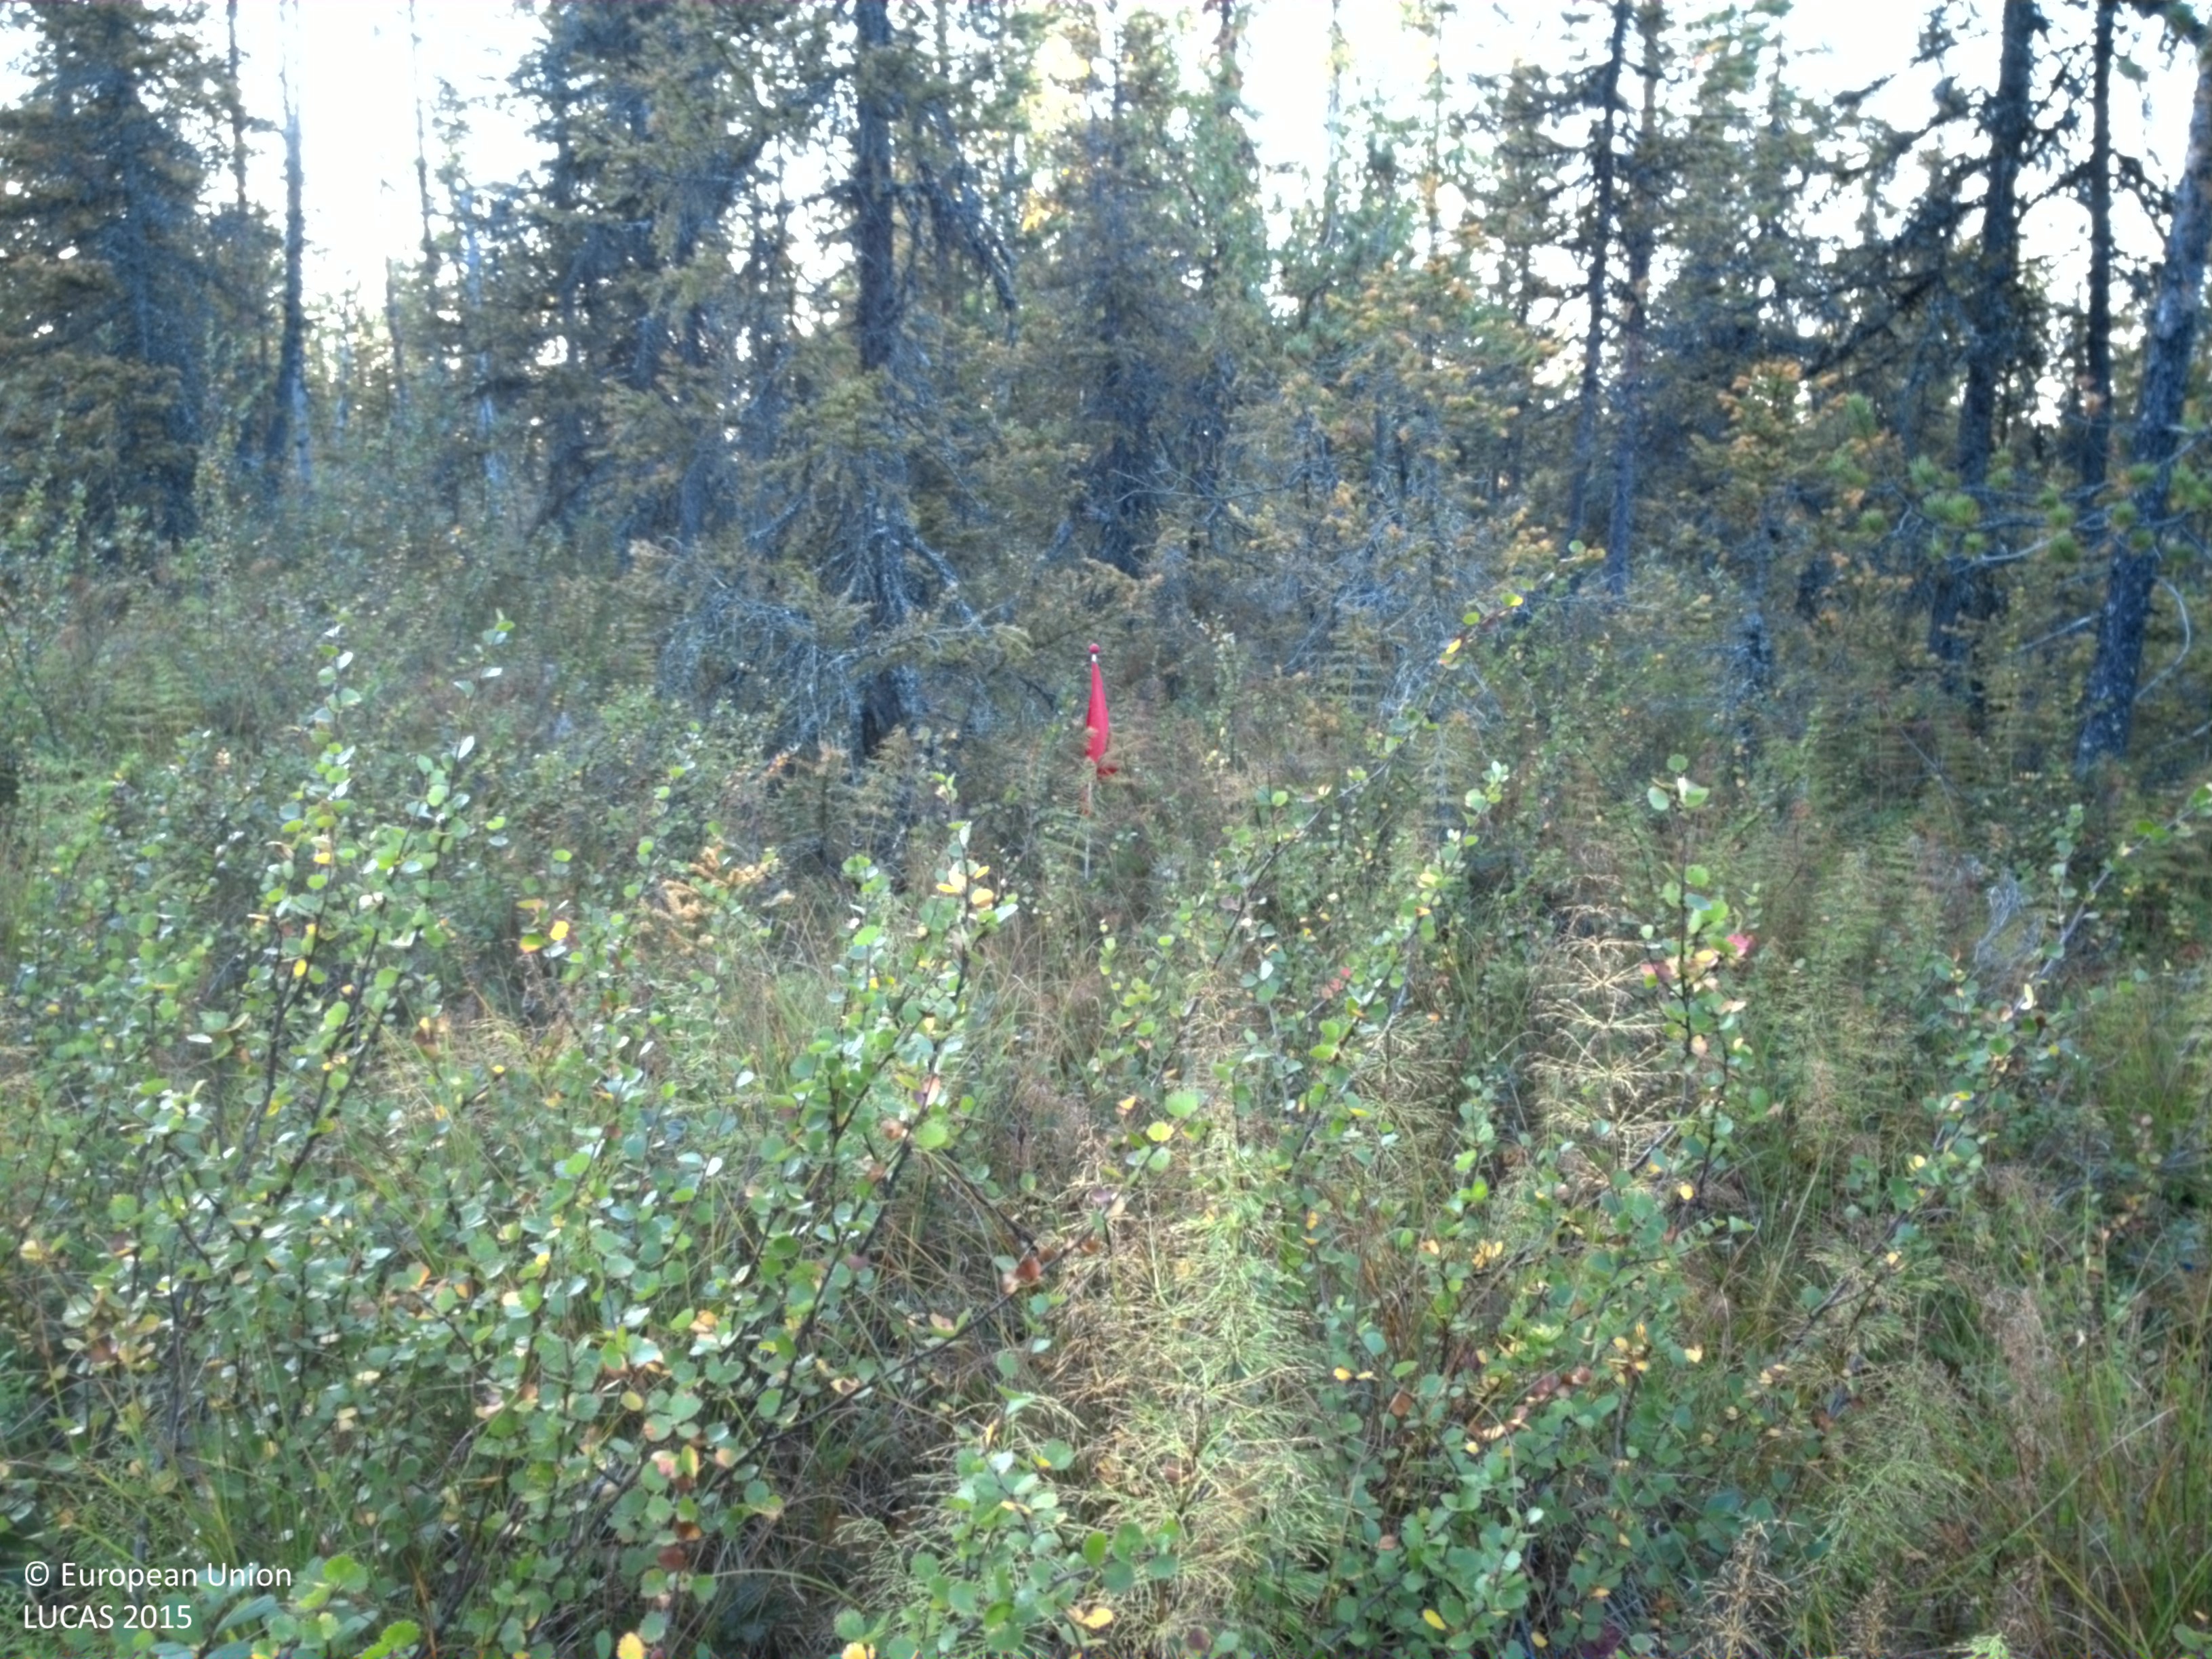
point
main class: Woodland
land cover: Spruce dominated coniferous woodland
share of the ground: 25 - 50 %
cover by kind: shrubs 70 %, coniferous forest trees 30 %
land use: Forestry
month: August
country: SE
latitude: 66.7285
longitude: 19.9996
